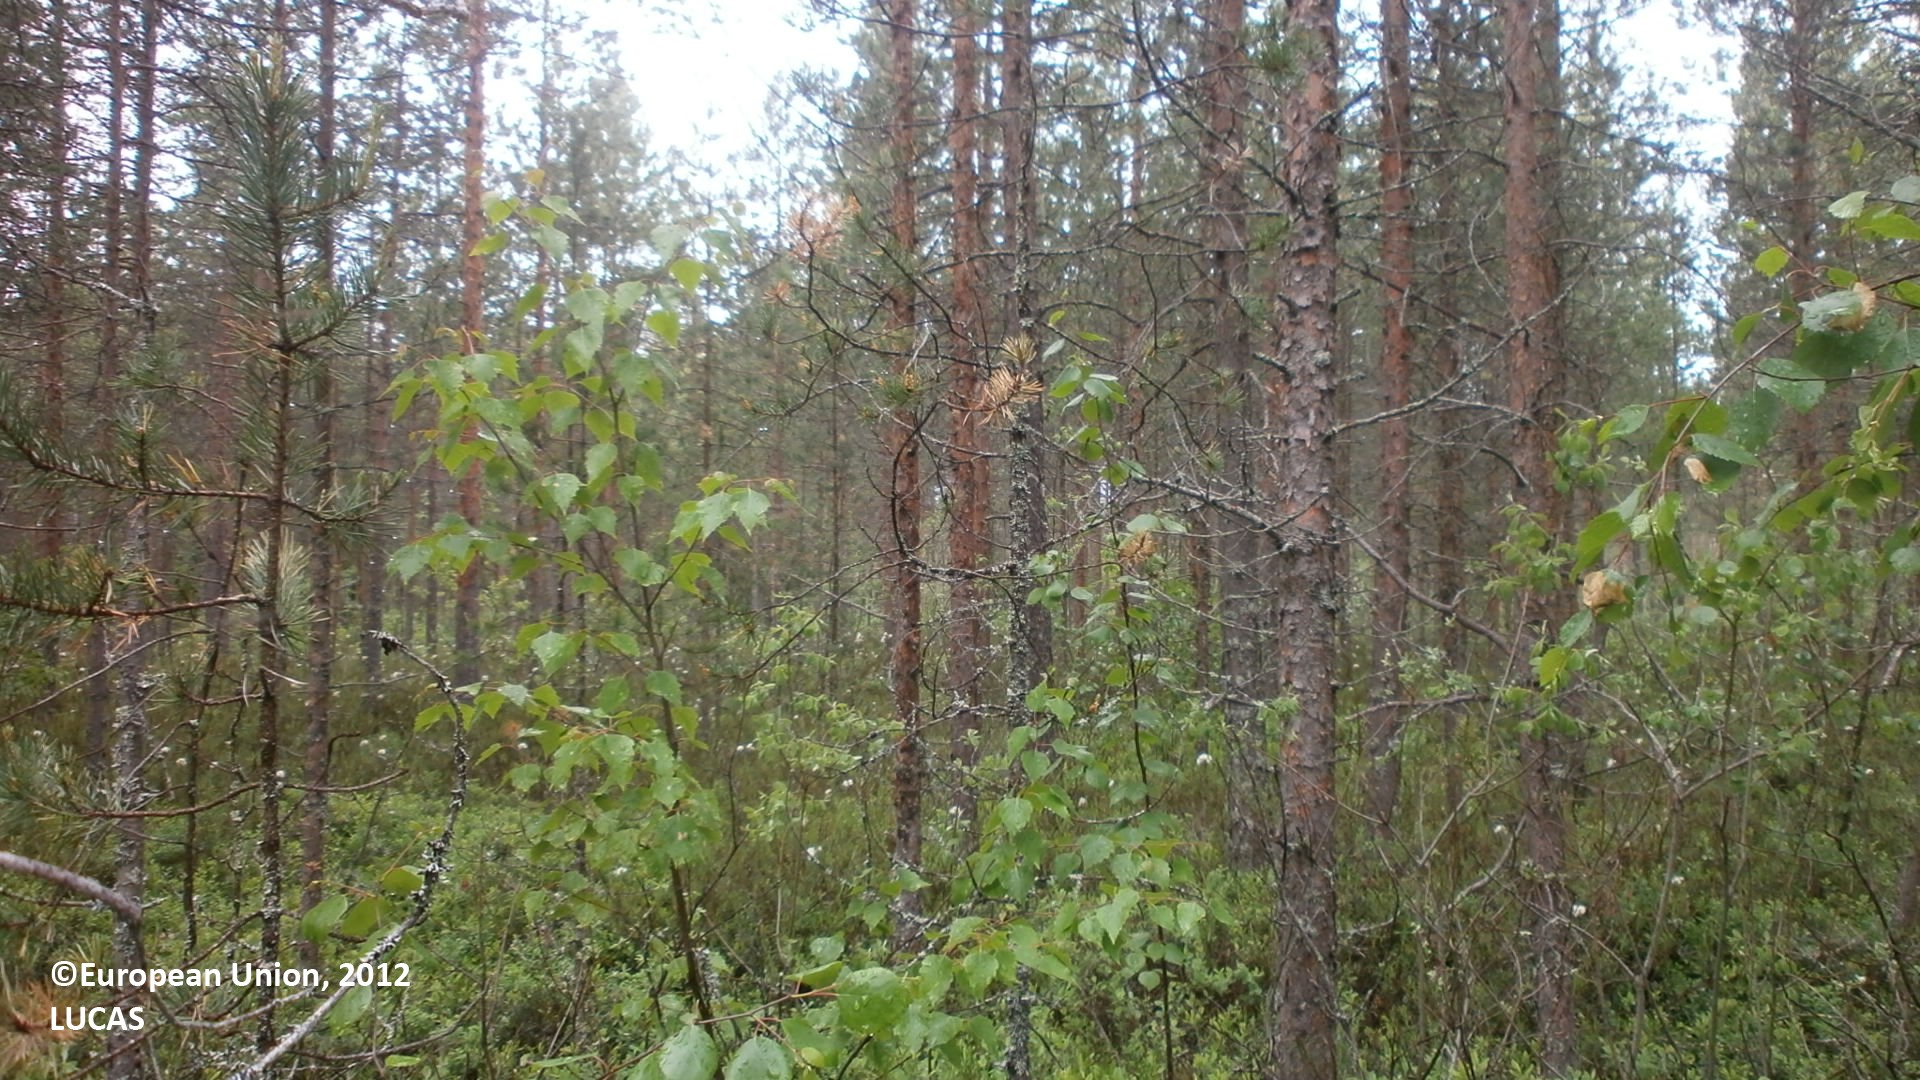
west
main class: Woodland
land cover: Pine dominated coniferous woodland
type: mire and swamp forests
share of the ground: > 75 %
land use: Forestry
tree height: > 5 m
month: June
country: FI
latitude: 64.7782
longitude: 25.2884
